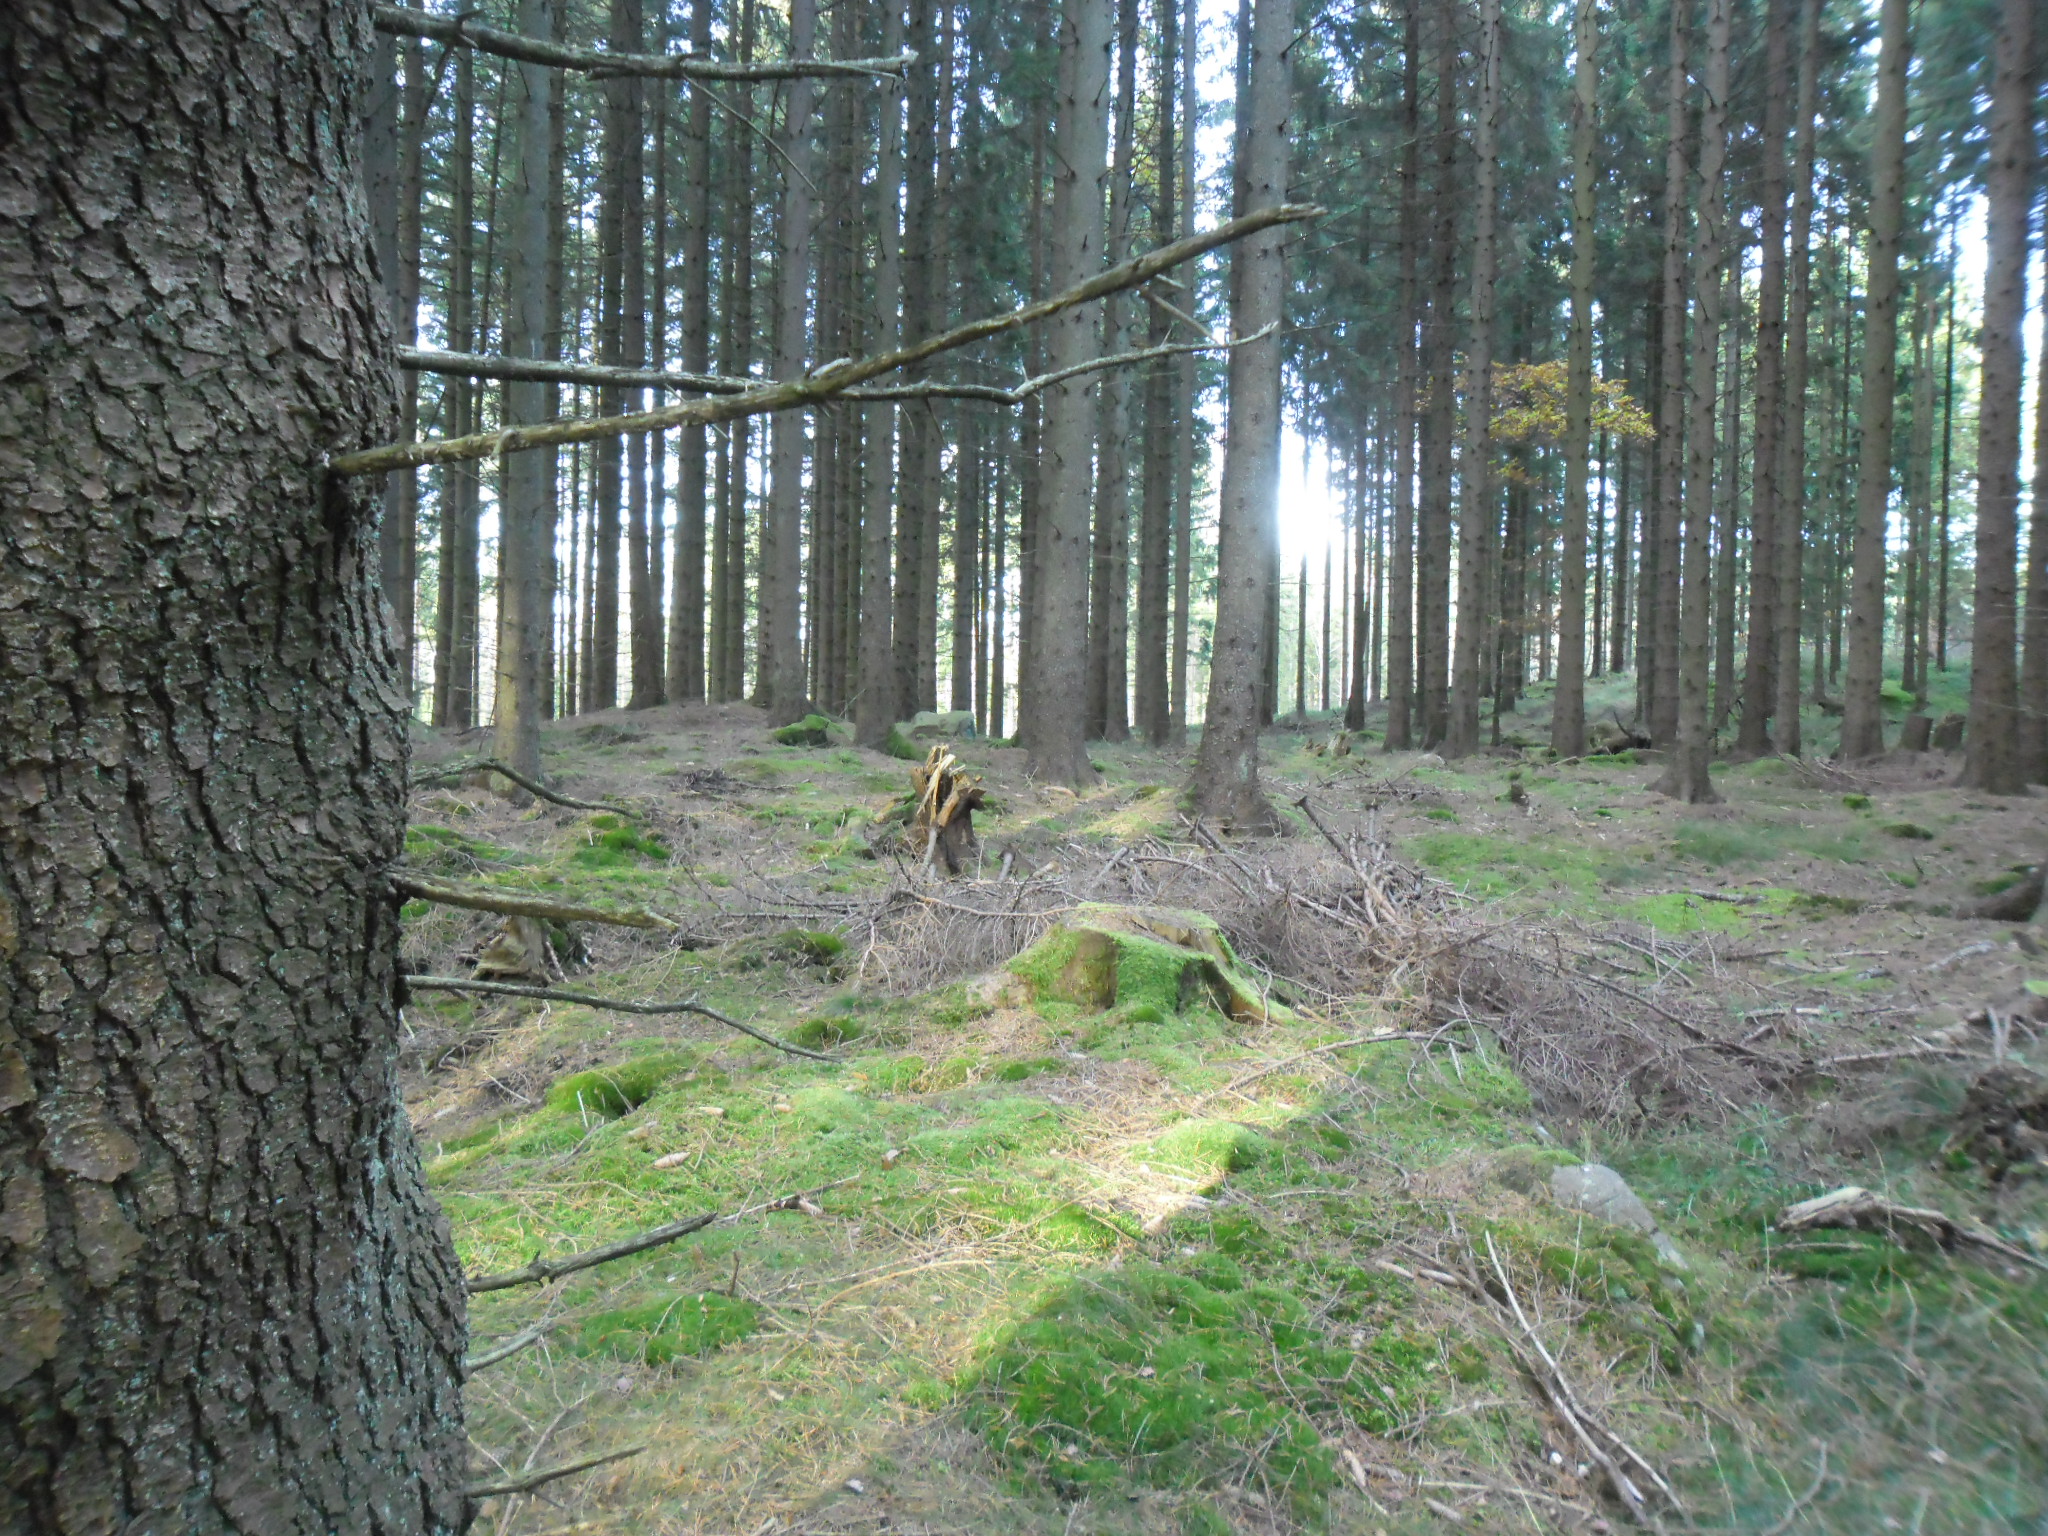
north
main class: Woodland
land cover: Spruce dominated coniferous woodland
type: boreal forest
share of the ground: > 75 %
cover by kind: coniferous forest trees 80 %, lichens and mosses 20 %
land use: Forestry
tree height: > 5 m
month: October
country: SE
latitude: 56.4001
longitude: 13.1891
